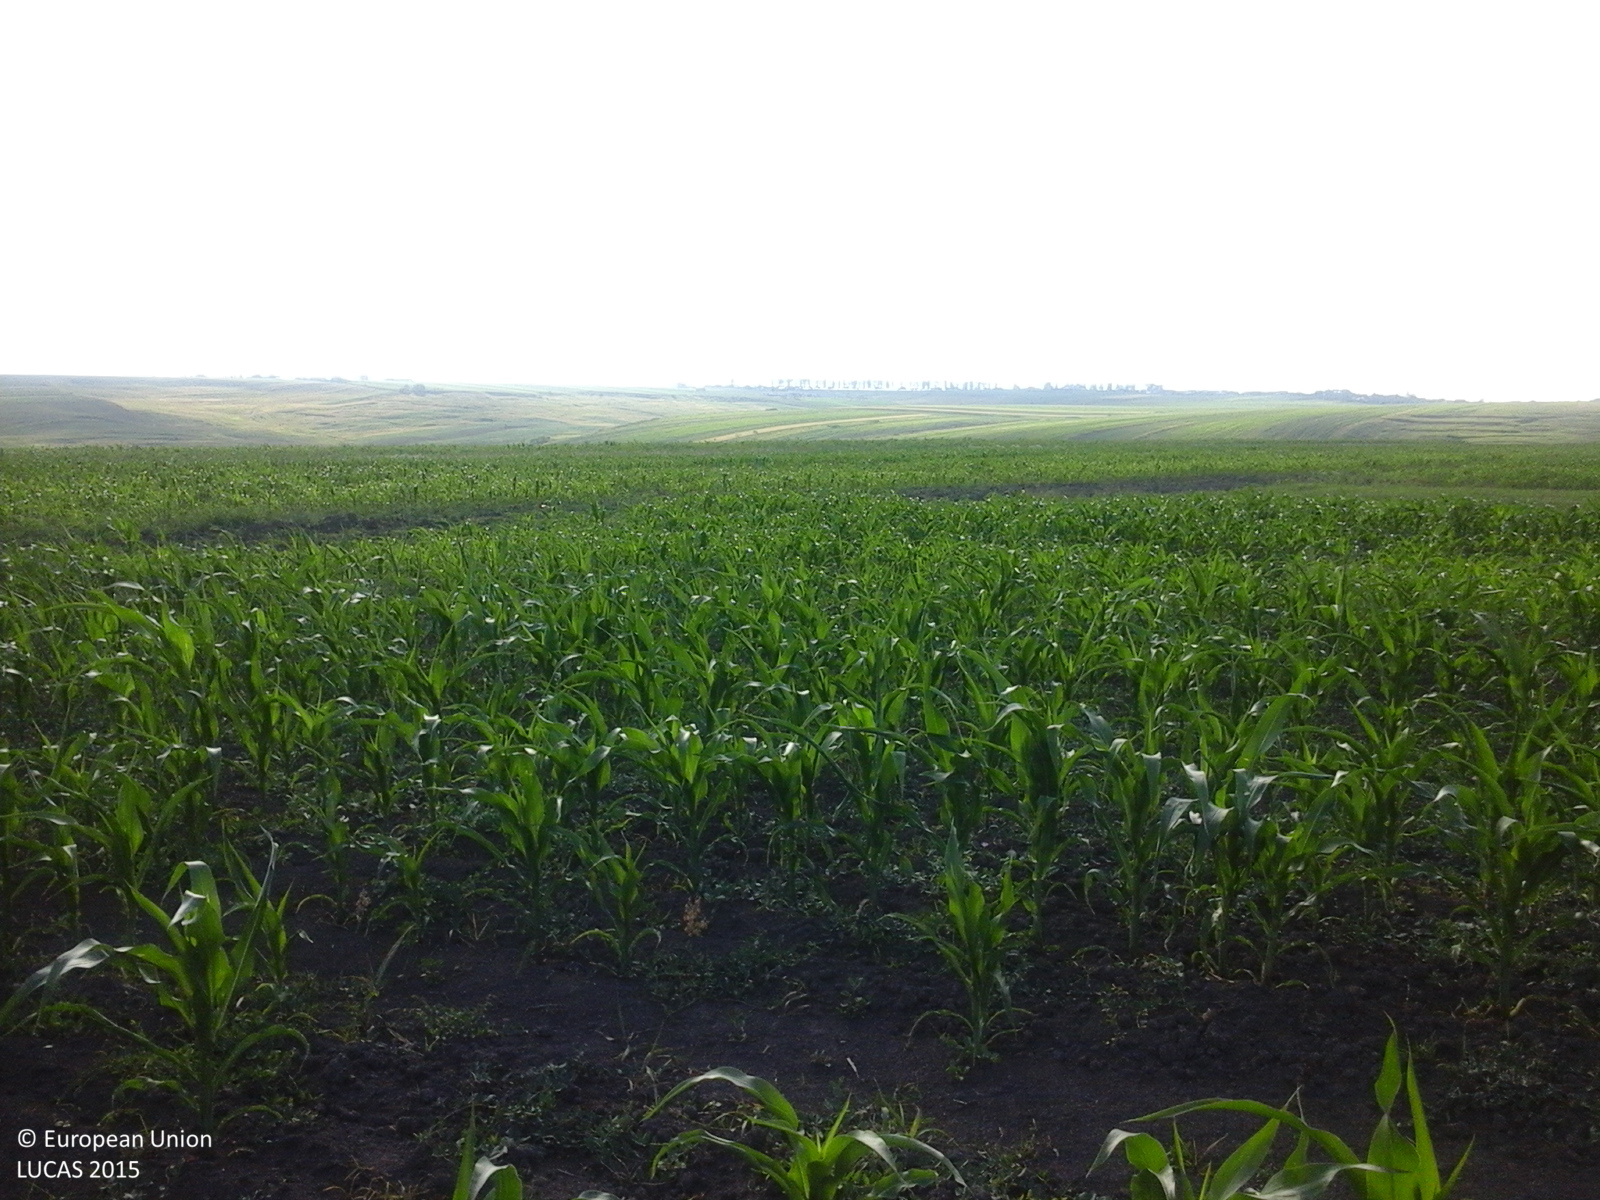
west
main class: Cropland
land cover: Maize
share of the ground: 25 - 50 %
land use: Agriculture (excluding fallow land and kitchen gardens)
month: June
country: RO
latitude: 47.7081
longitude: 26.8259
